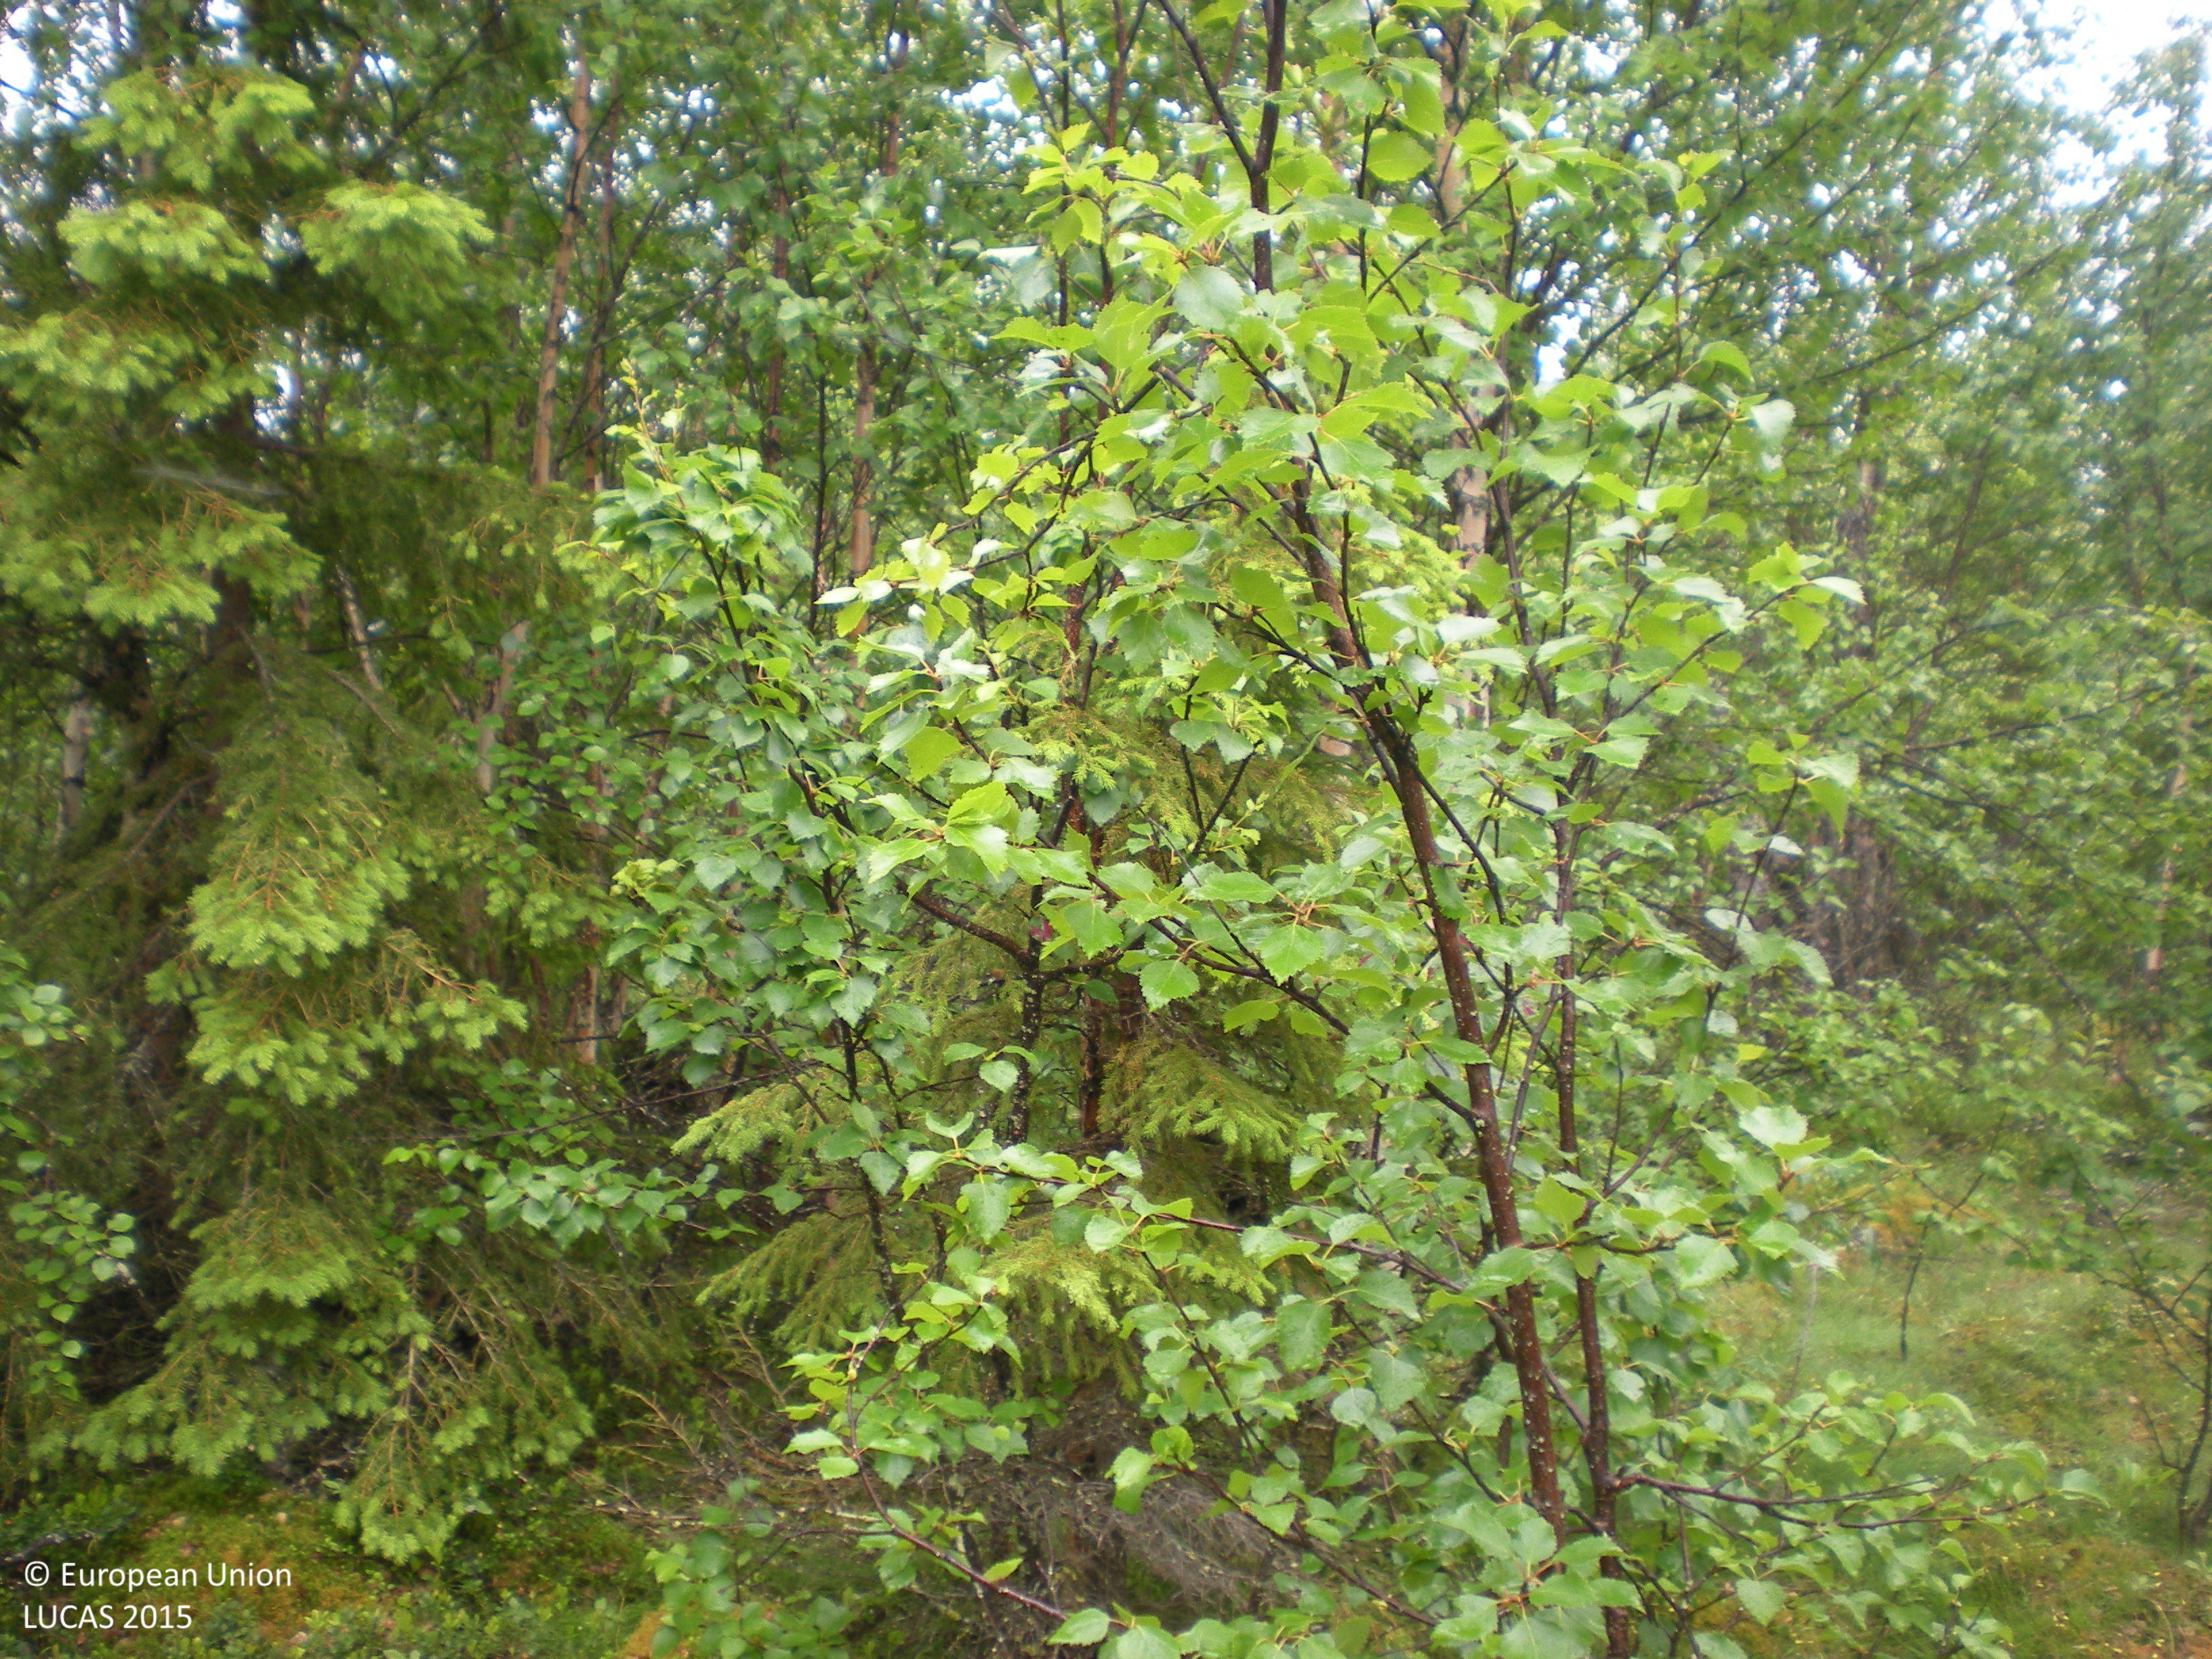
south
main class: Woodland
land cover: Spruce dominated mixed woodland
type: boreal forest
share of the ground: 50 - 75 %
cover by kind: broadleaved forest trees 55 %, coniferous forest trees 20 %, herbaceous plants 15 %, lichens and mosses 10 %
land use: Forestry
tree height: > 5 m
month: July
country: SE
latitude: 65.8700
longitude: 17.1697
